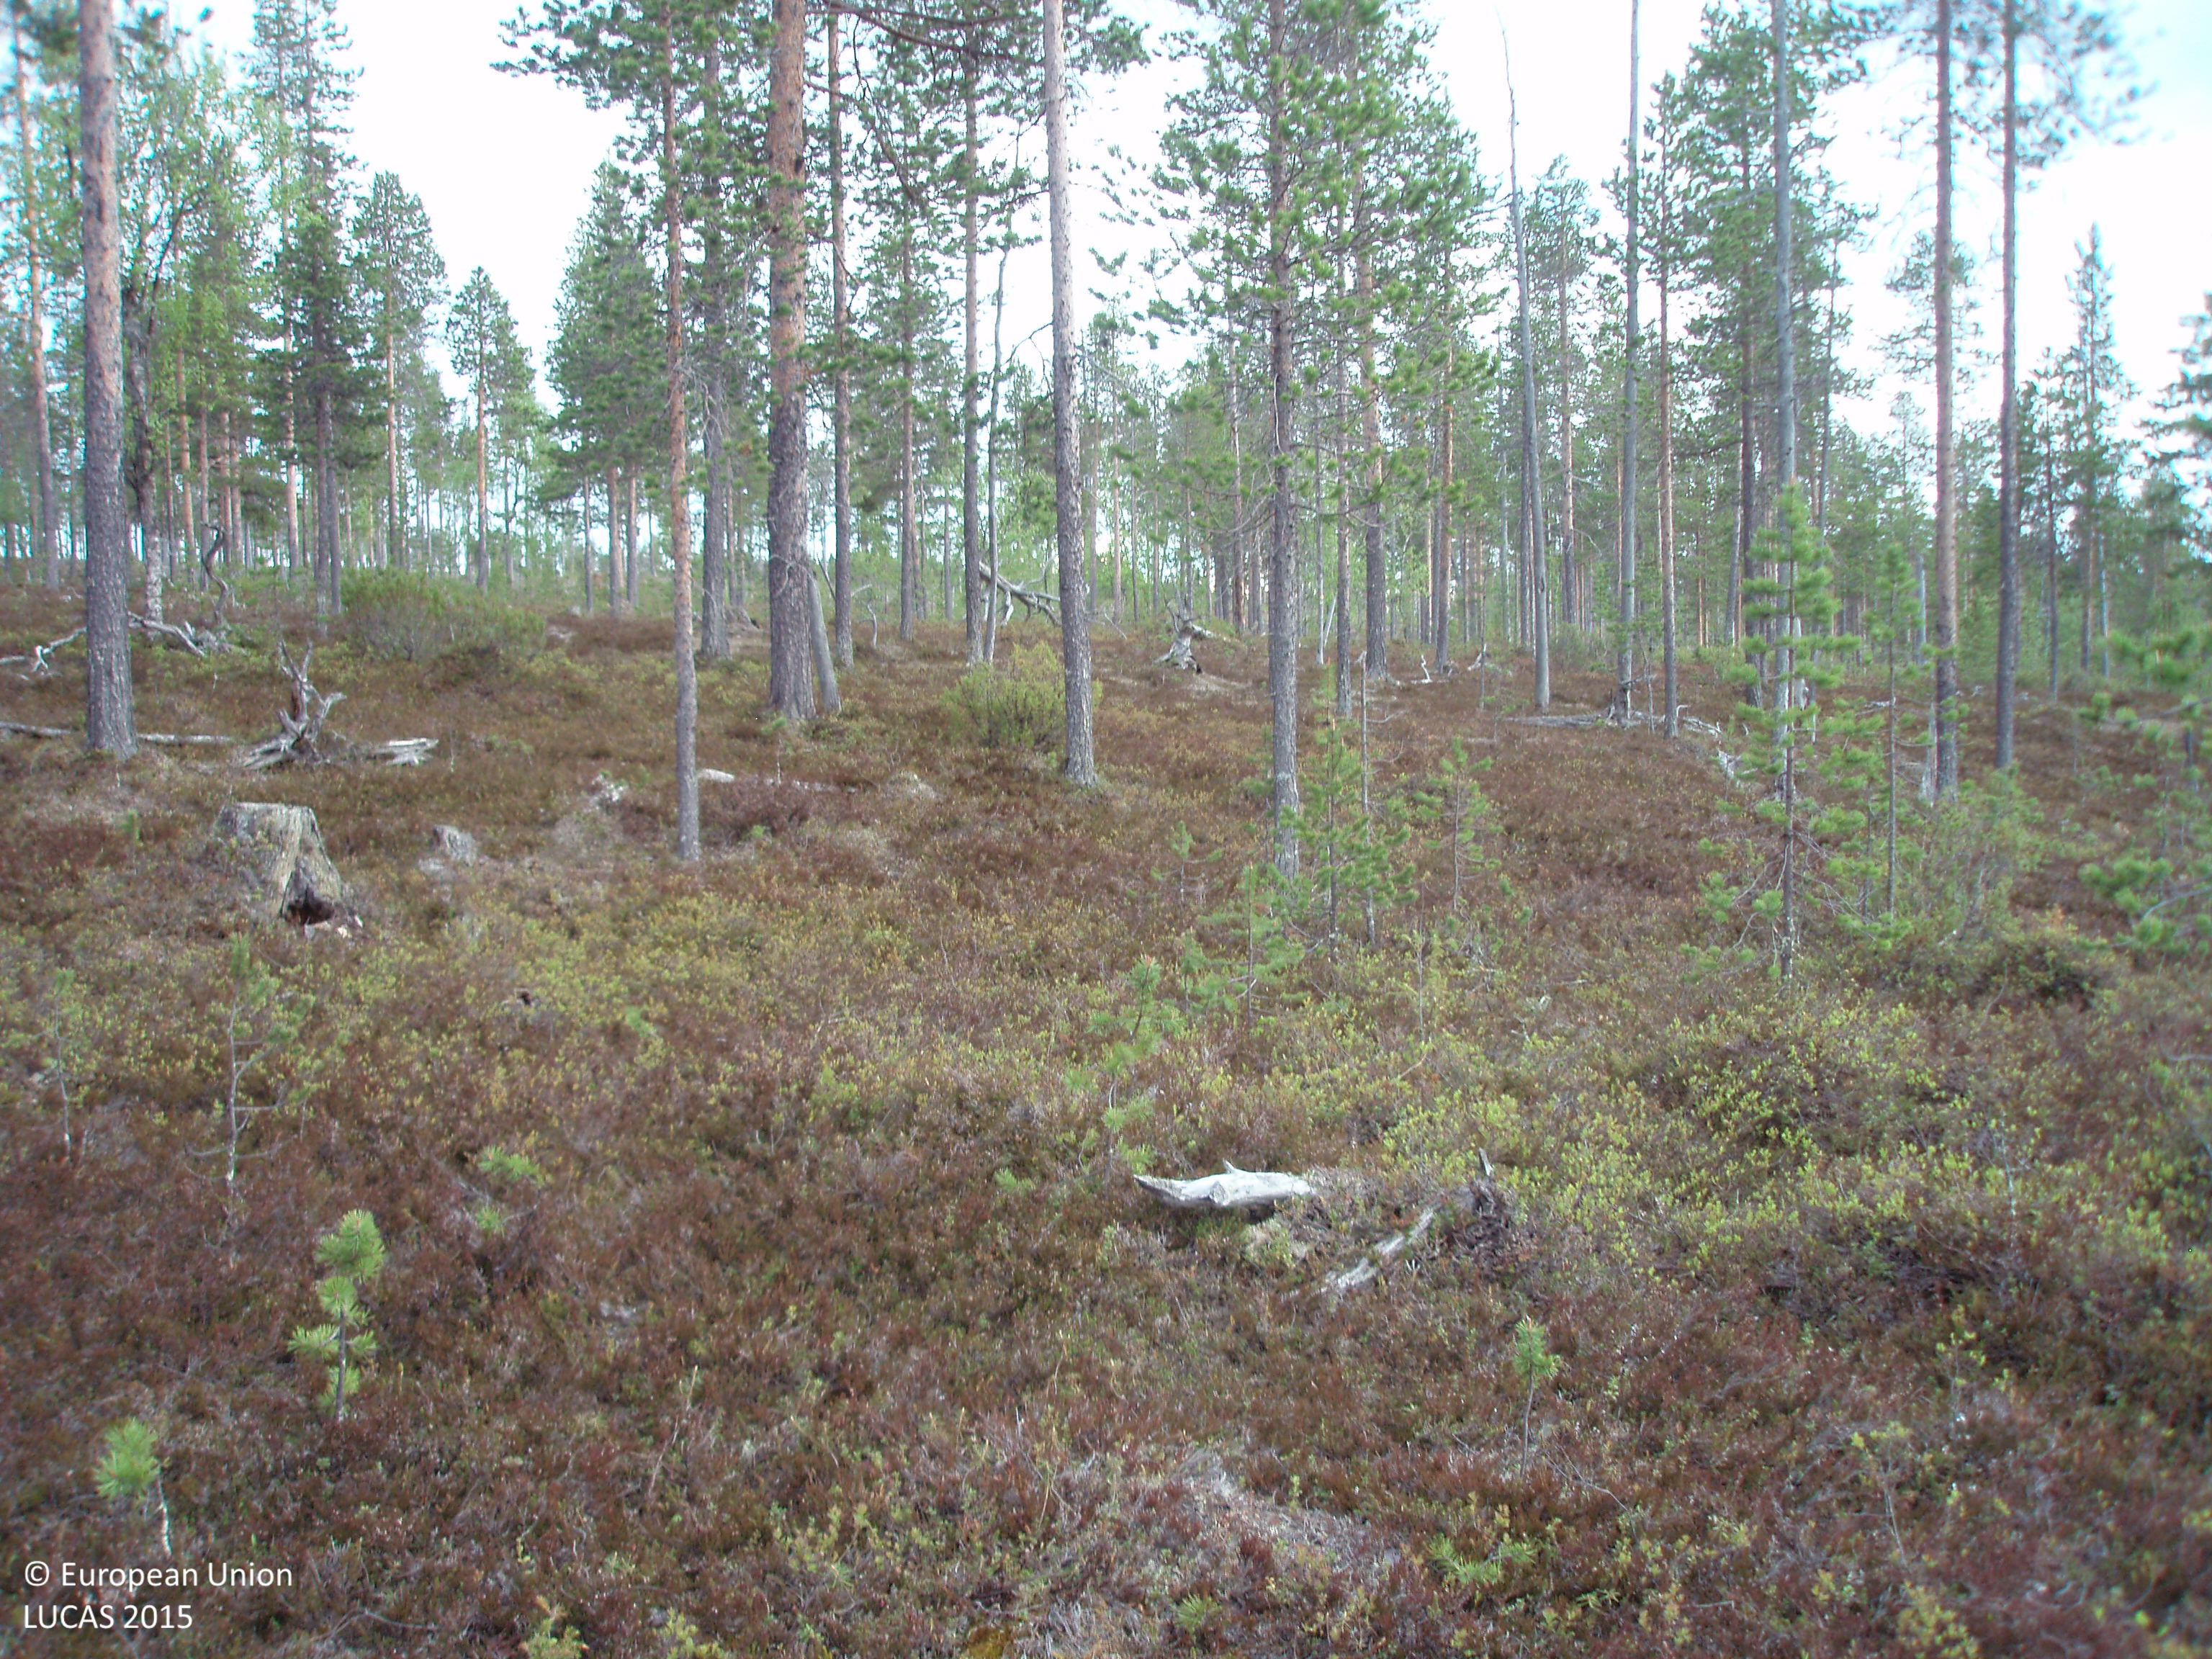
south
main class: Woodland
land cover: Pine dominated coniferous woodland
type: boreal forest
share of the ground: 25 - 50 %
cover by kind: shrubs 70 %, coniferous forest trees 25 %, lichens and mosses 5 %
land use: Forestry
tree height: > 5 m
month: June
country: FI
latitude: 68.4356
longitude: 27.8644
